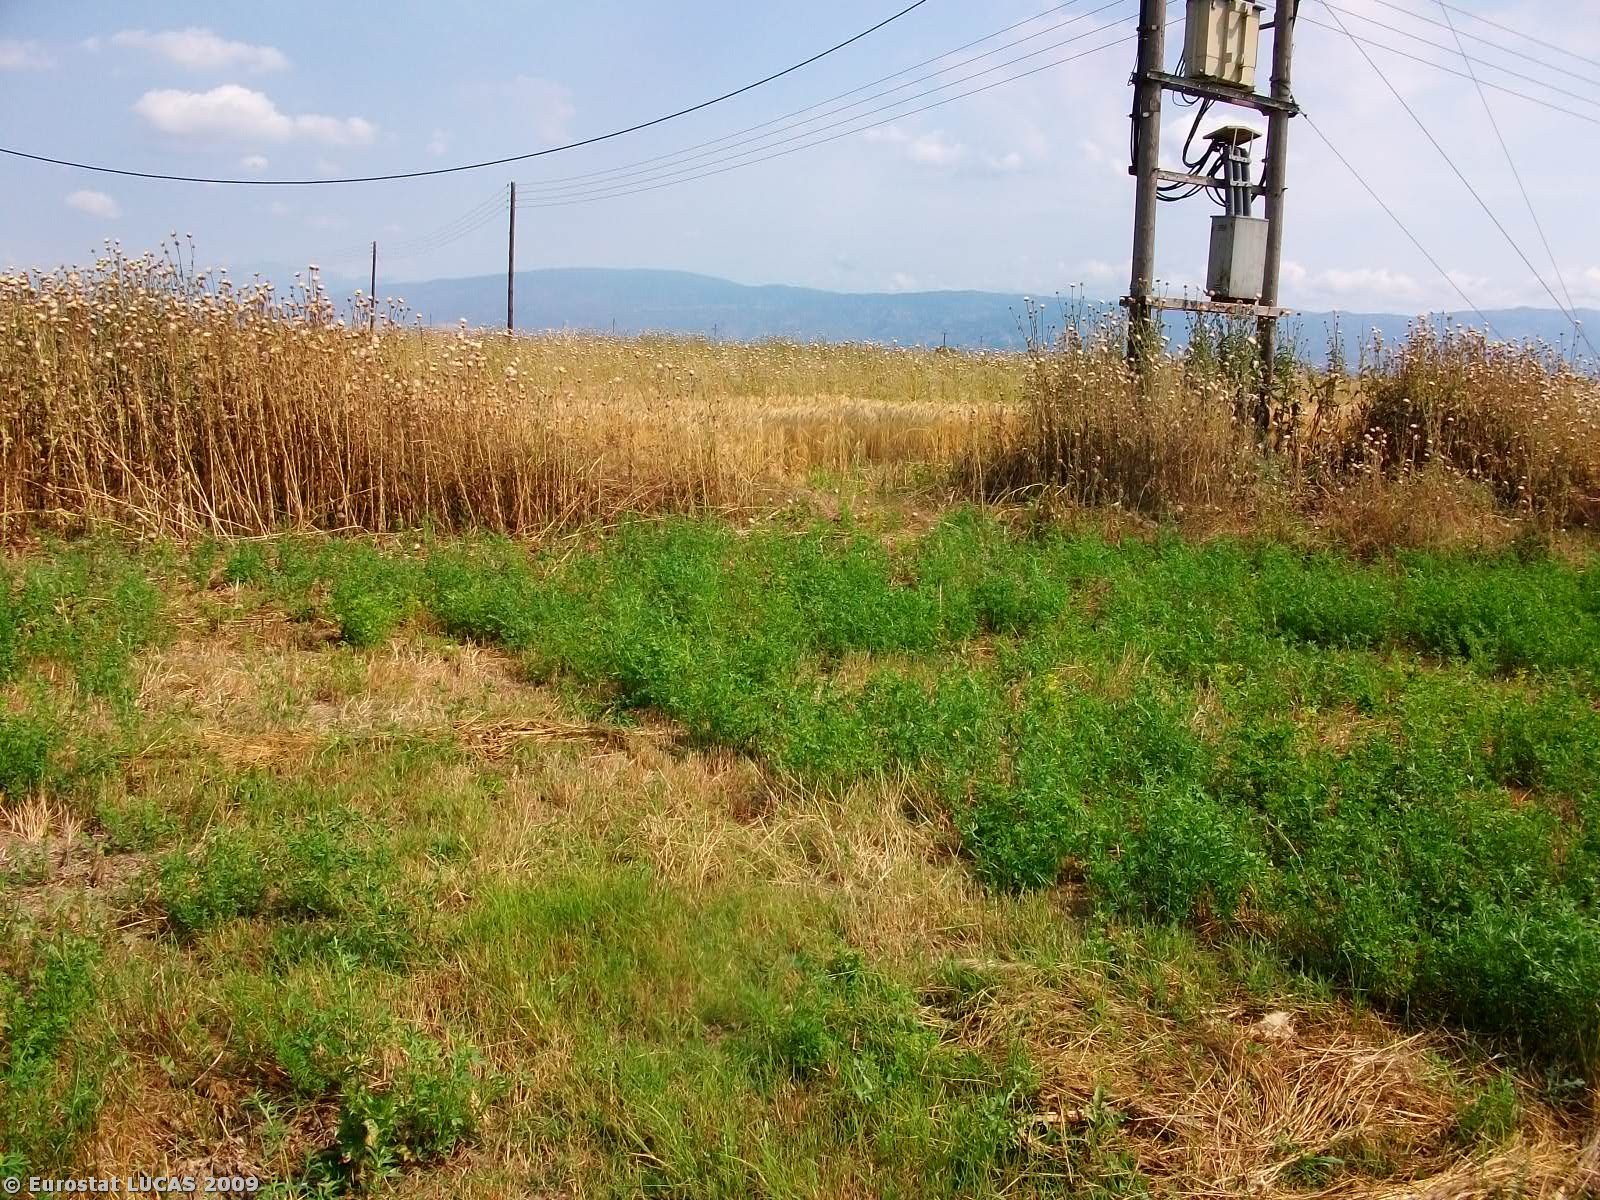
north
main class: Cropland
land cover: Lucerne
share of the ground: > 75 %
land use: Agriculture (excluding fallow land and kitchen gardens)
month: May
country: GR
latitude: 39.4307
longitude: 22.7580
